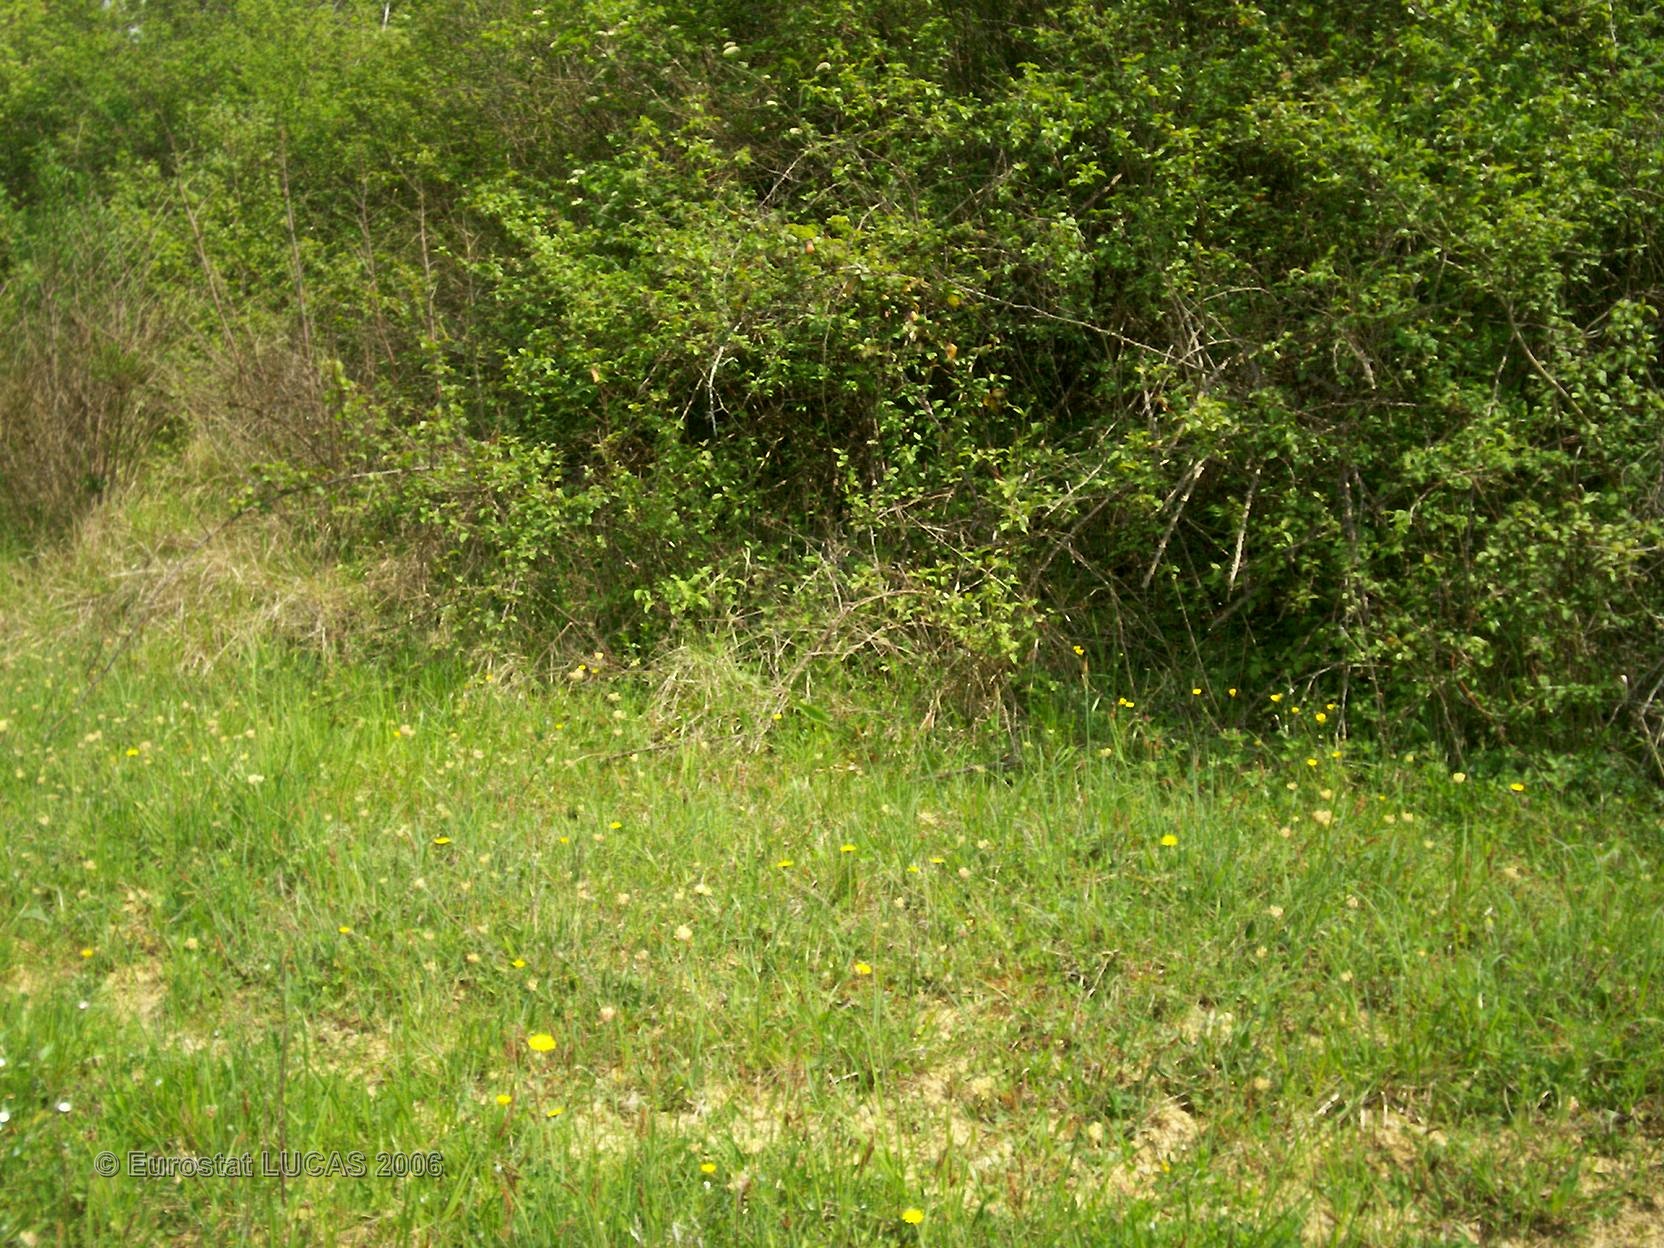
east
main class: Grassland
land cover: Grassland without tree/shrub cover
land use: Agriculture (excluding fallow land and kitchen gardens)
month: April
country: FR
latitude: 44.1571
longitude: 0.7805
